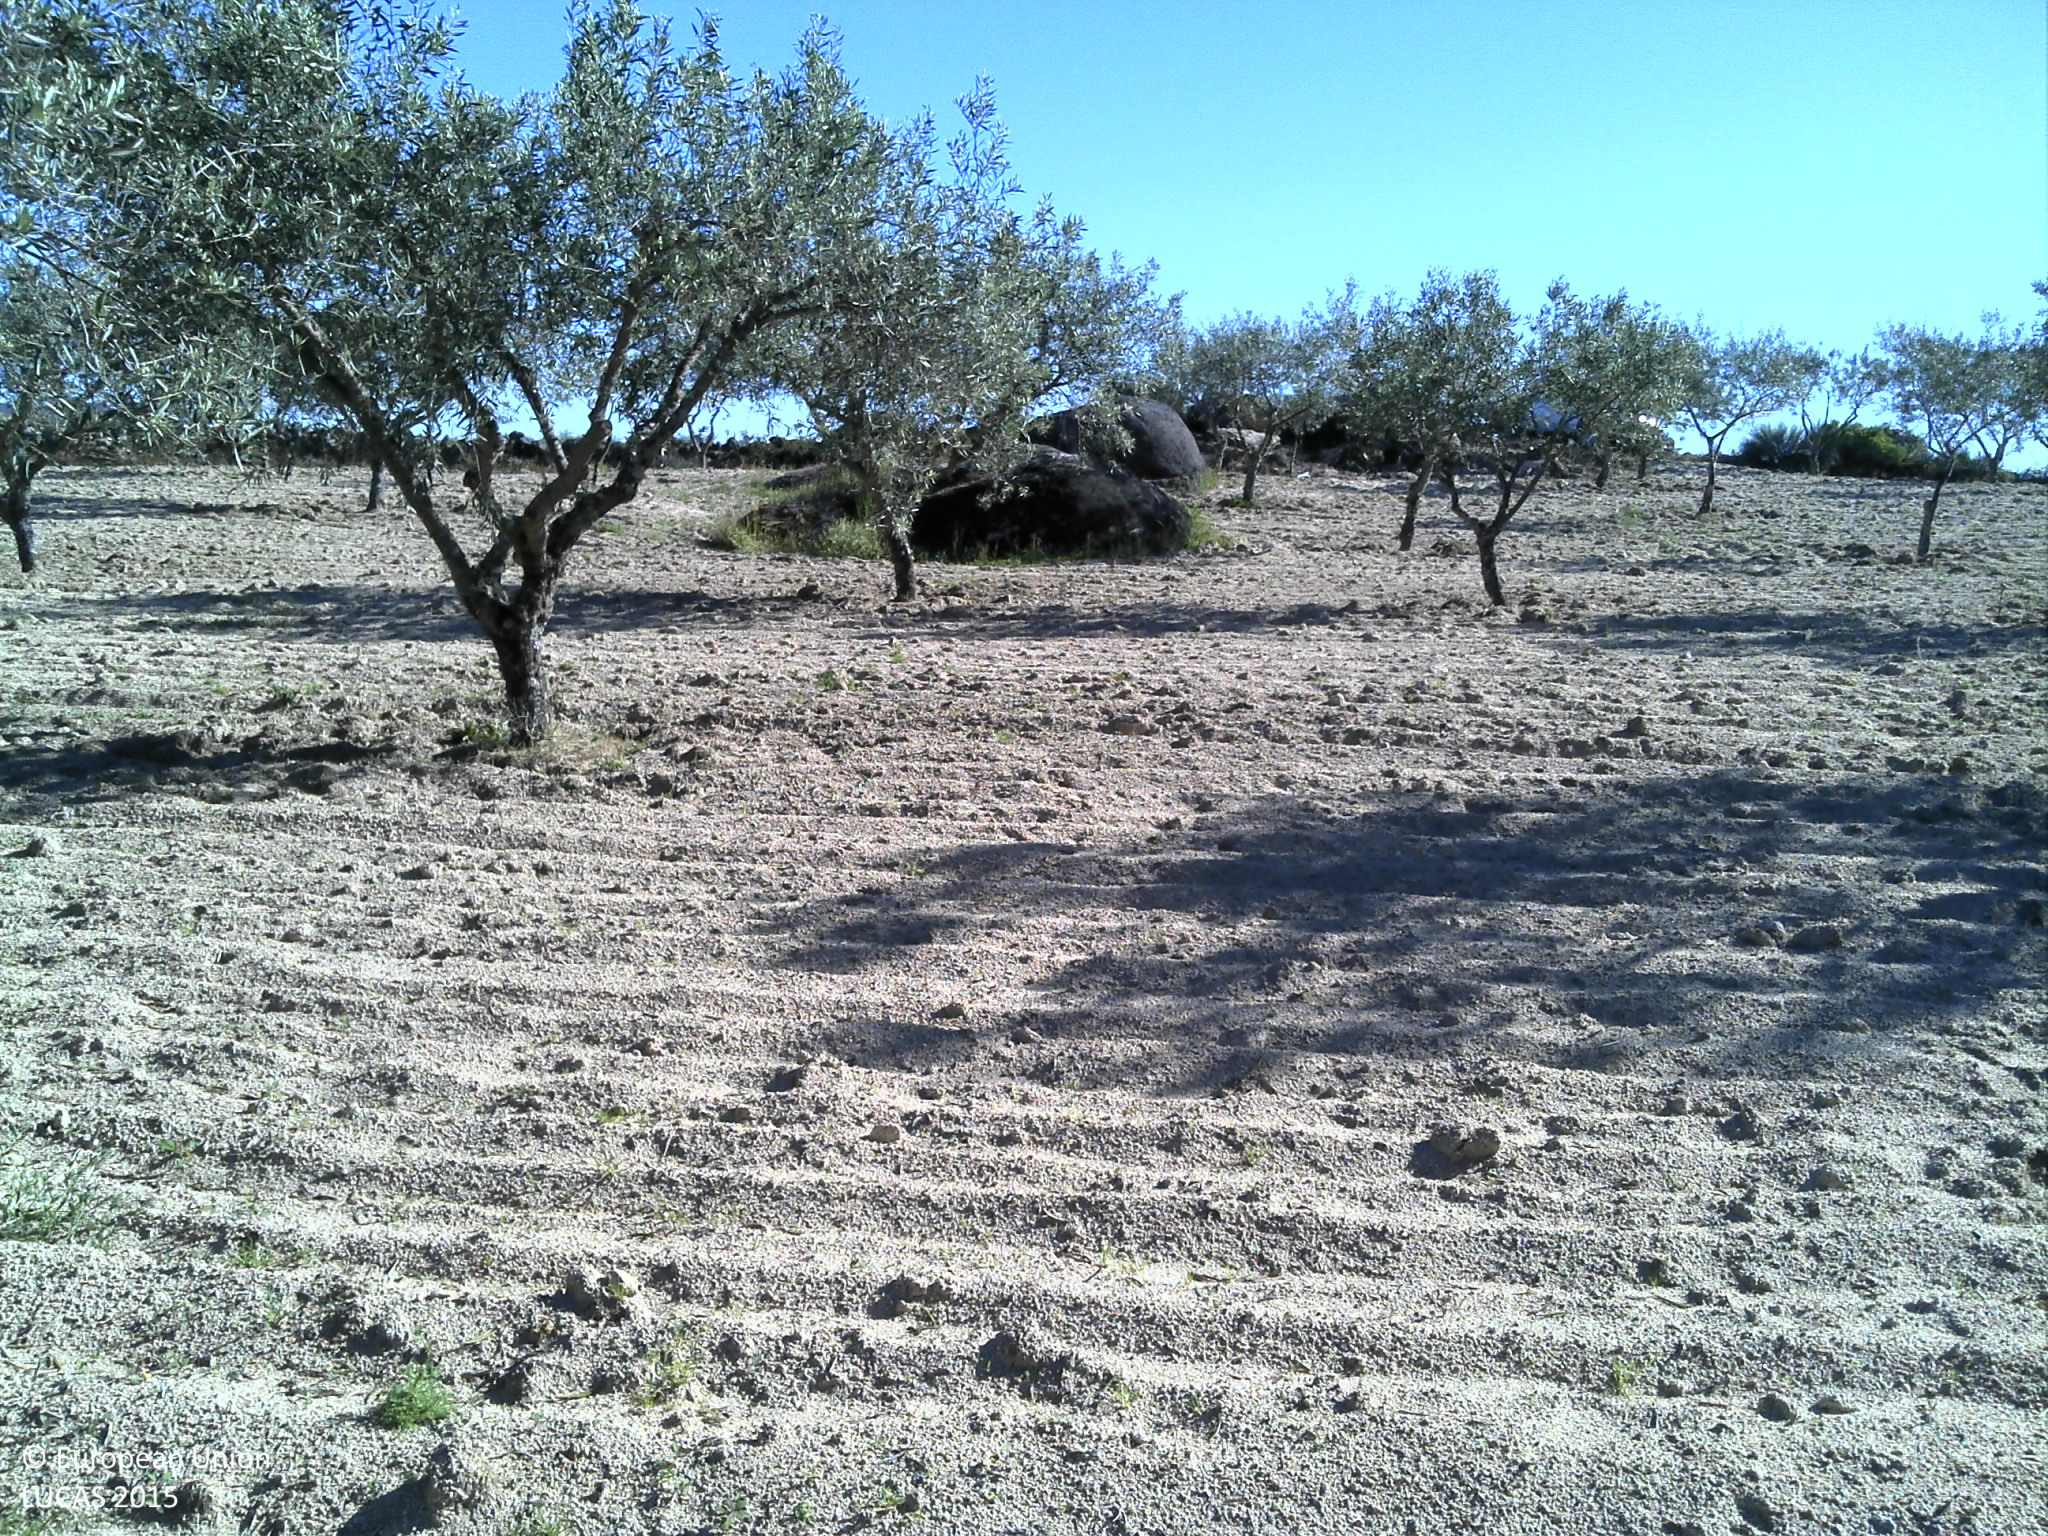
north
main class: Cropland
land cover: Olive groves
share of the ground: 25 - 50 %
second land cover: Other bare soil
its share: > 75 %
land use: Agriculture (excluding fallow land and kitchen gardens)
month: May
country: PT
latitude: 41.7257
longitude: -7.1807
